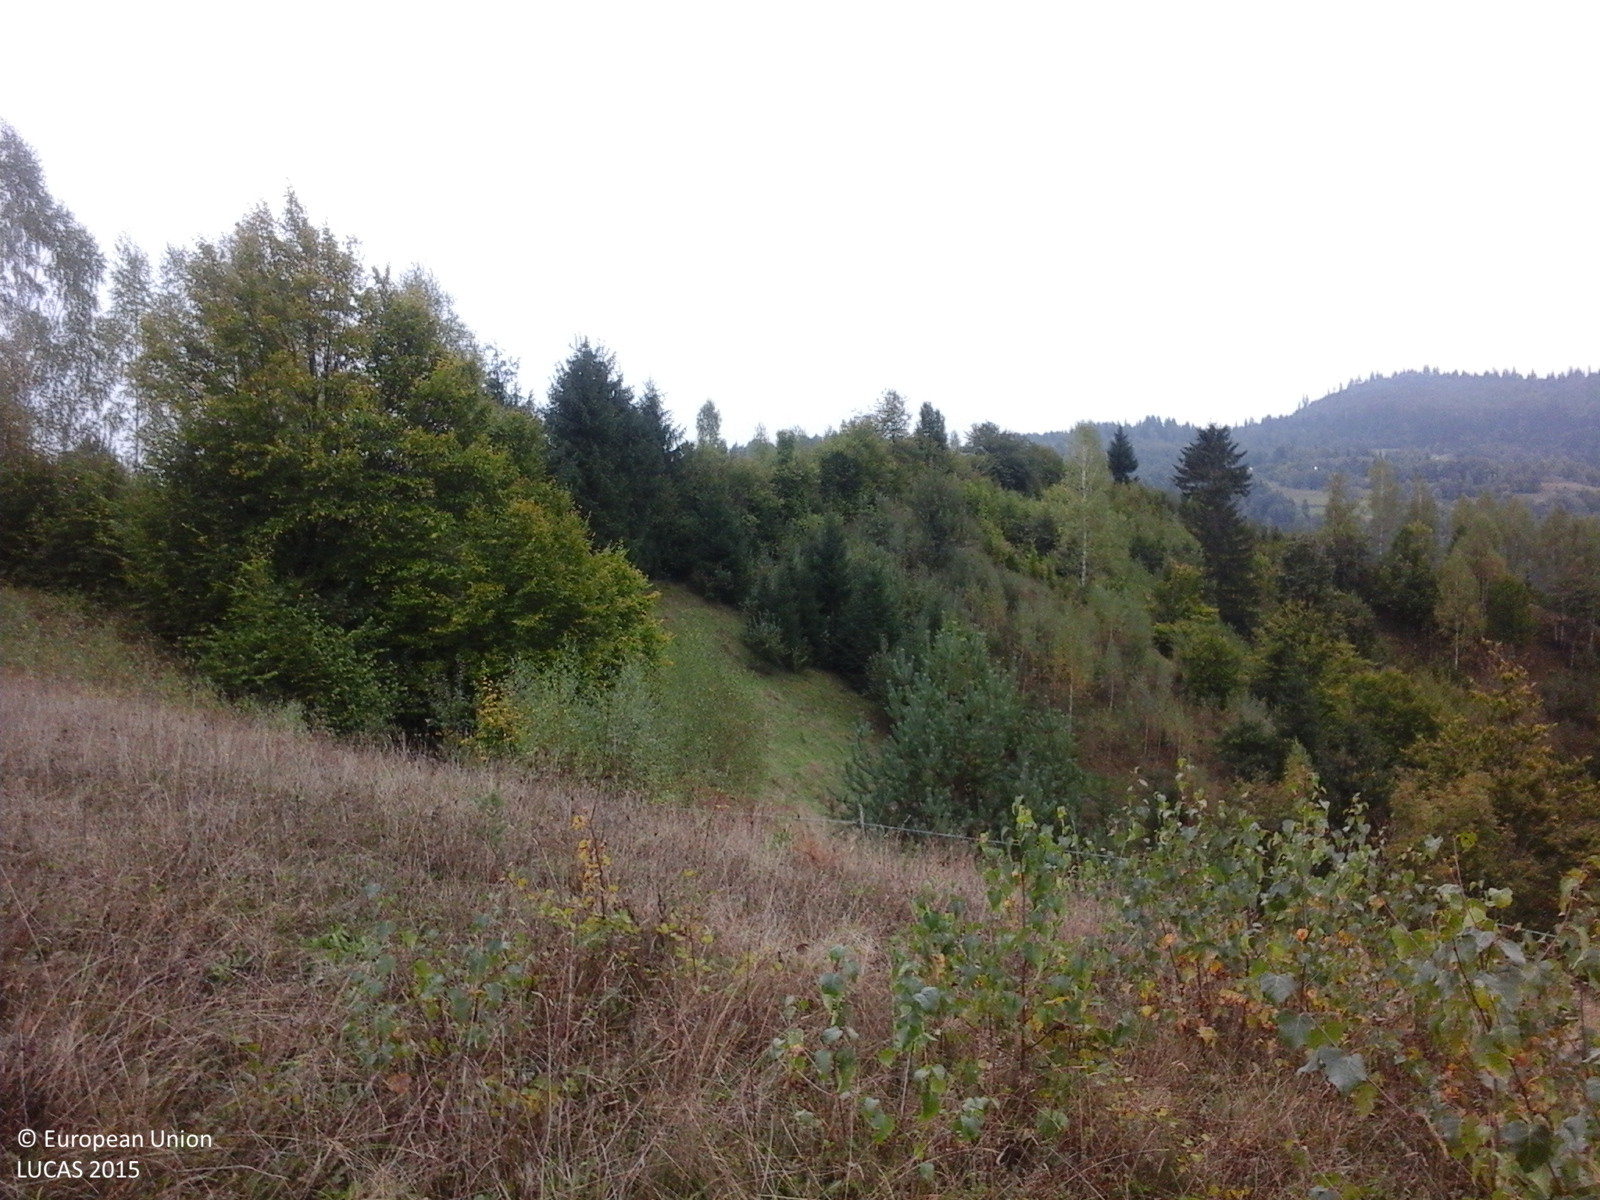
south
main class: Grassland
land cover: Grassland with sparse tree/shrub cover
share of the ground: > 75 %
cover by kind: herbaceous plants 85 %, shrubs 10 %, broadleaved forest trees 5 %
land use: Agriculture (excluding fallow land and kitchen gardens)
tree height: > 5 m
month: October
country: RO
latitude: 46.3593
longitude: 23.1222
